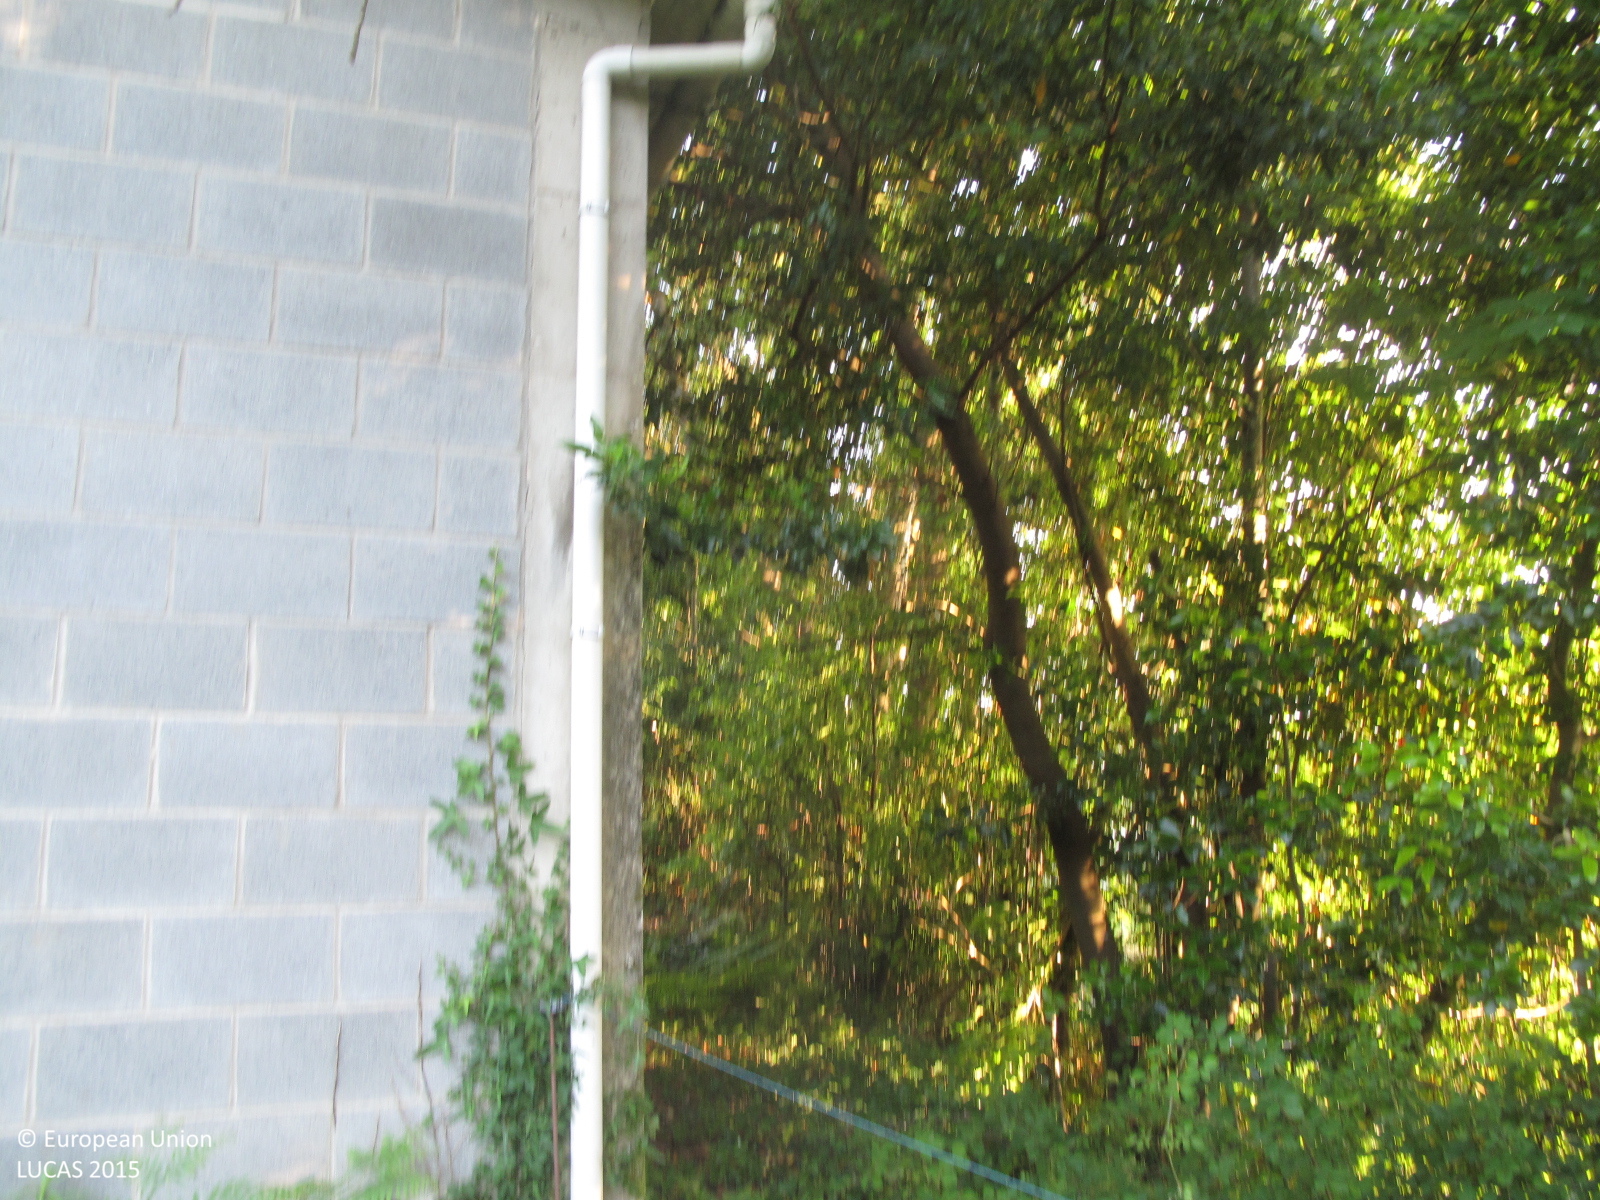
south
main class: Grassland
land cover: Grassland without tree/shrub cover
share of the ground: > 75 %
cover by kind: herbaceous plants 90 %, unconsolidated bare surface 10 %
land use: Agriculture (excluding fallow land and kitchen gardens)
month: July
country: ES
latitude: 43.5479
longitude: -8.0323
